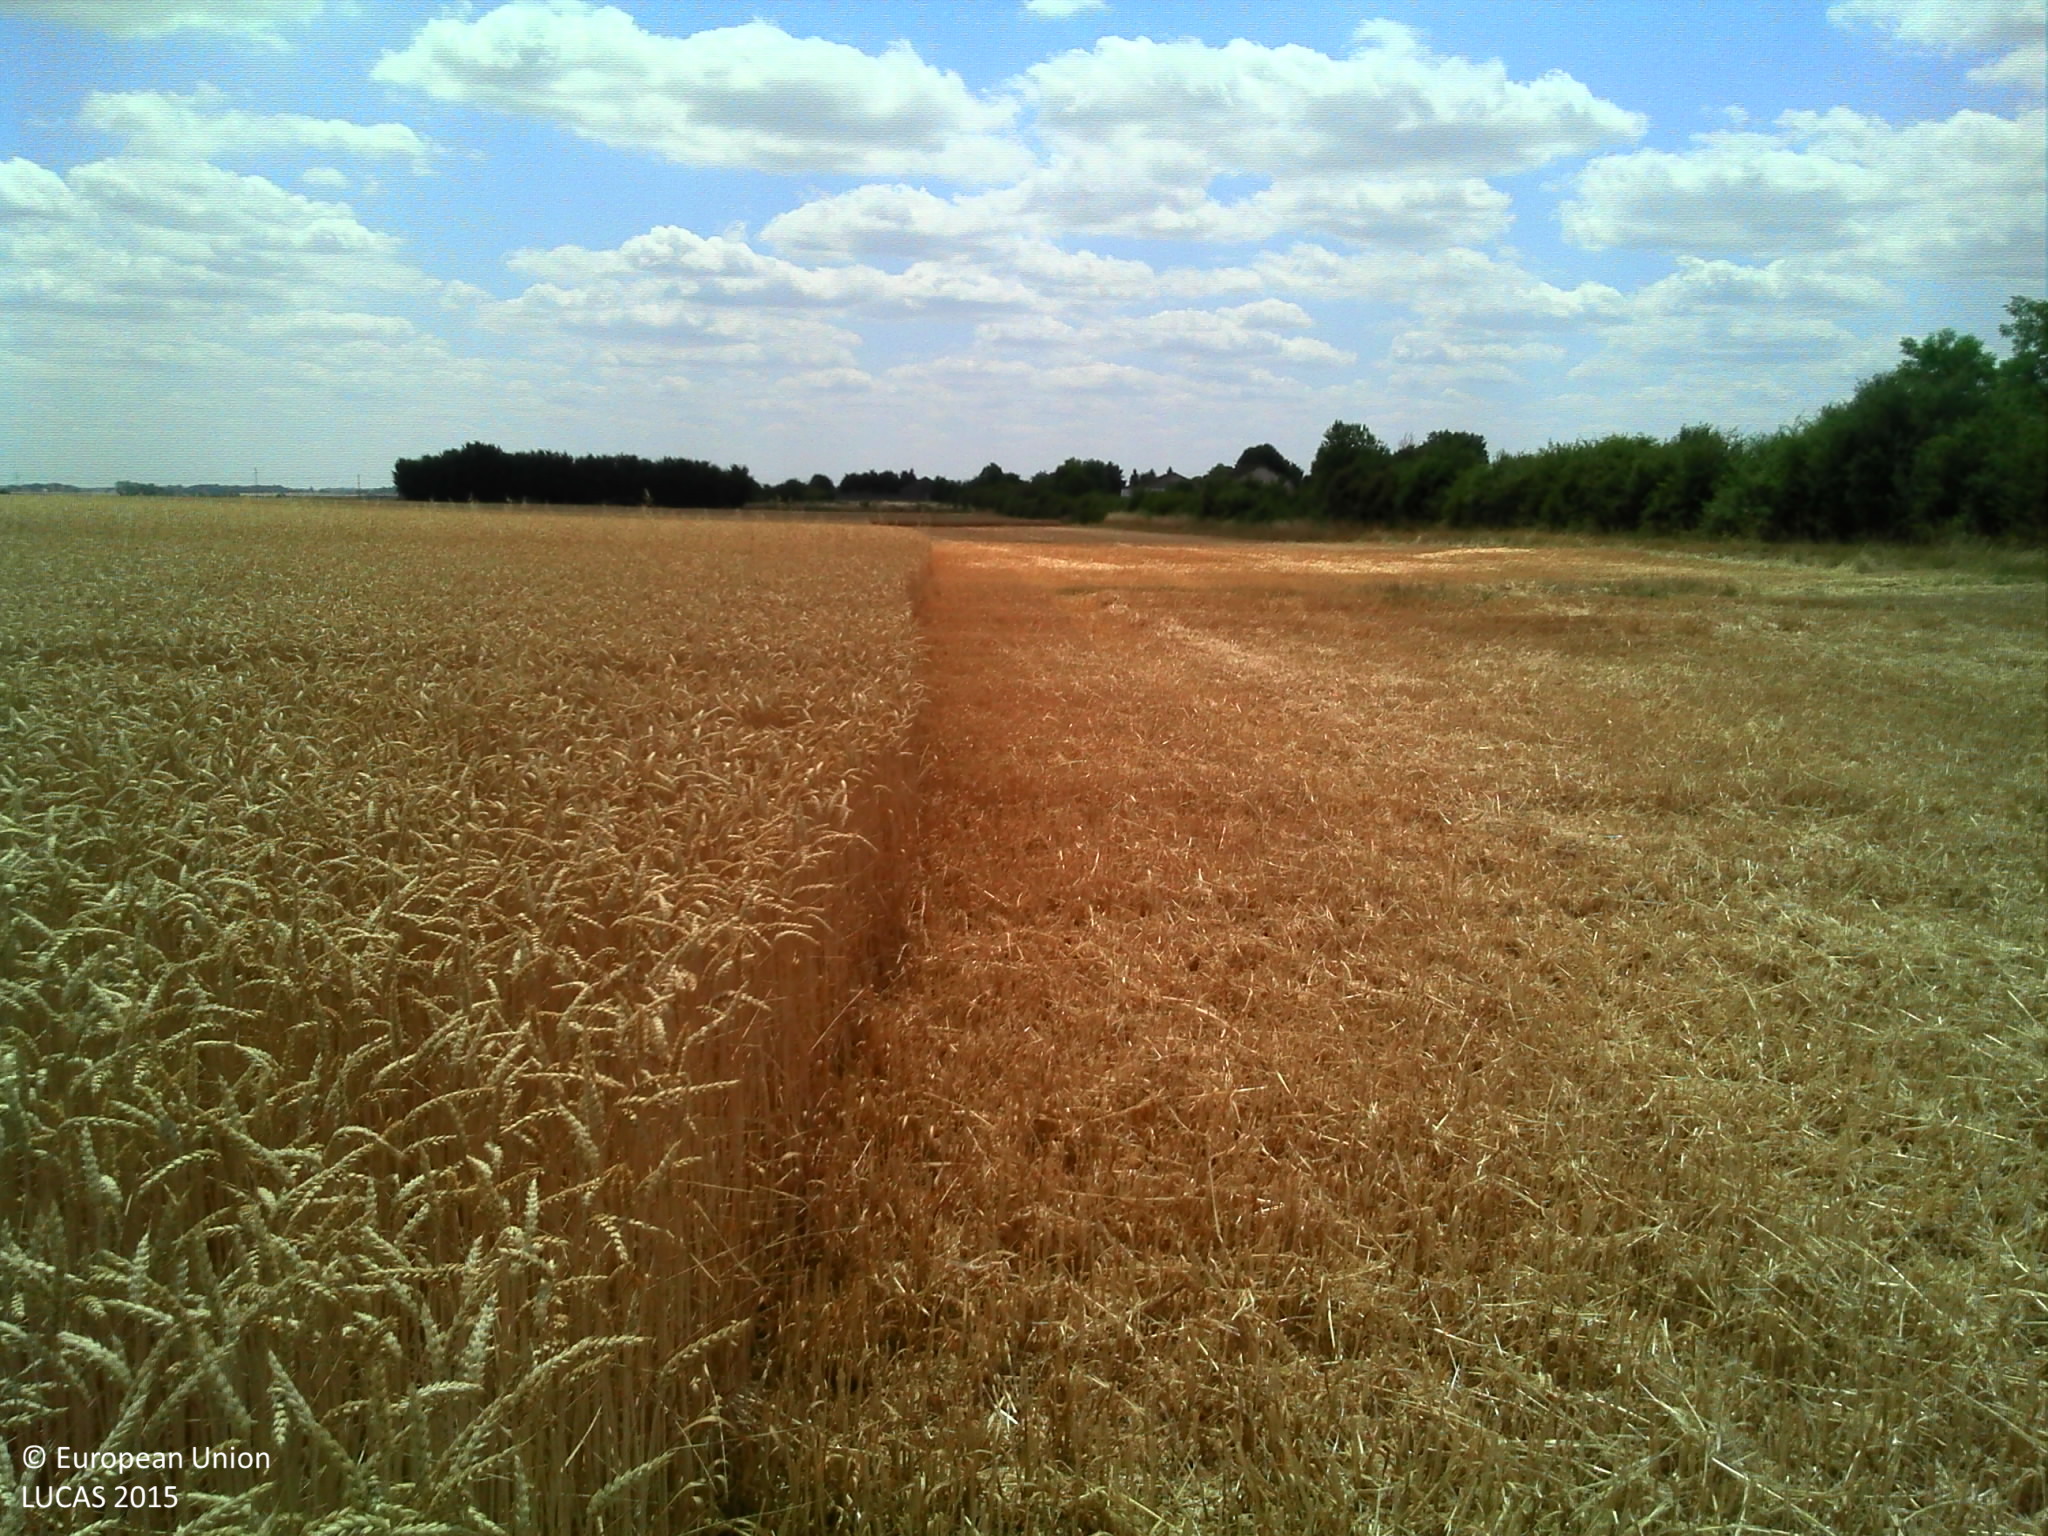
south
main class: Cropland
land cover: Common wheat
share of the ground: > 75 %
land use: Agriculture (excluding fallow land and kitchen gardens)
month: July
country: FR
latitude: 48.0933
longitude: 2.4846
